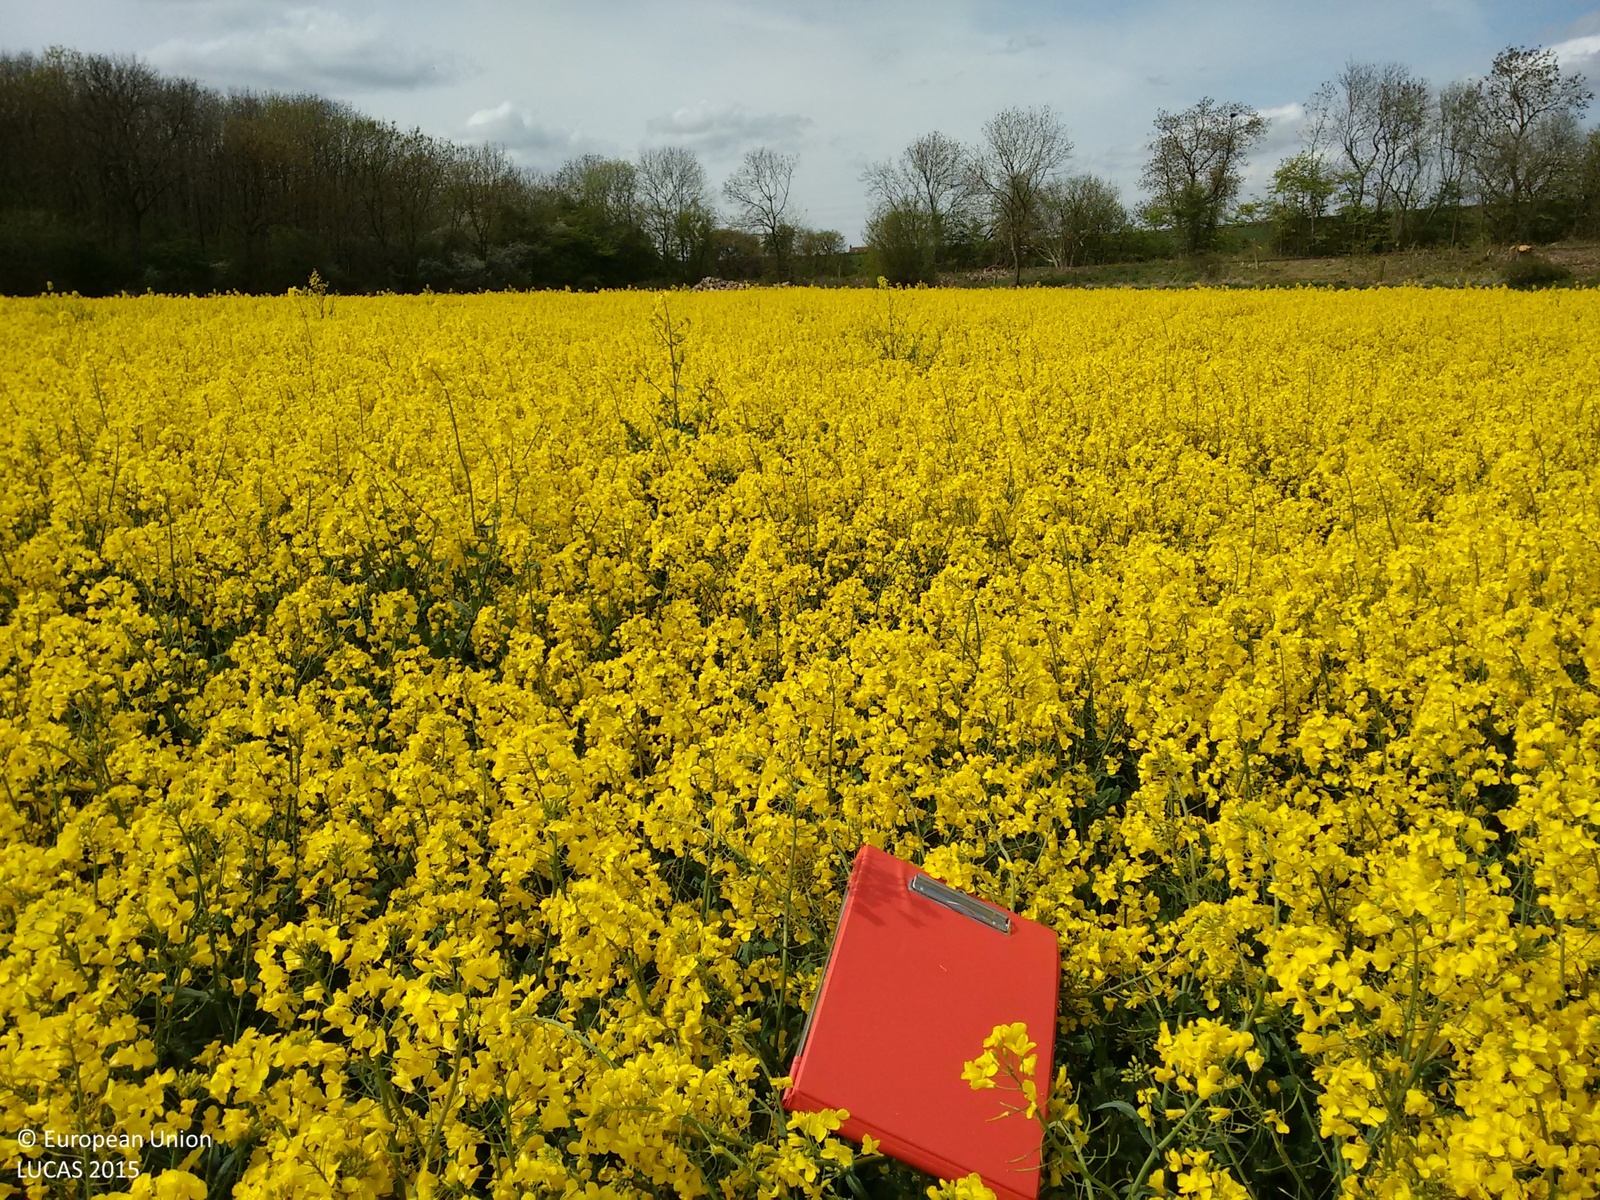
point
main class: Cropland
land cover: Rape and turnip rape
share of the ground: > 75 %
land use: Agriculture (excluding fallow land and kitchen gardens)
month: May
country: GB
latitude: 51.9739
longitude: -0.7998
